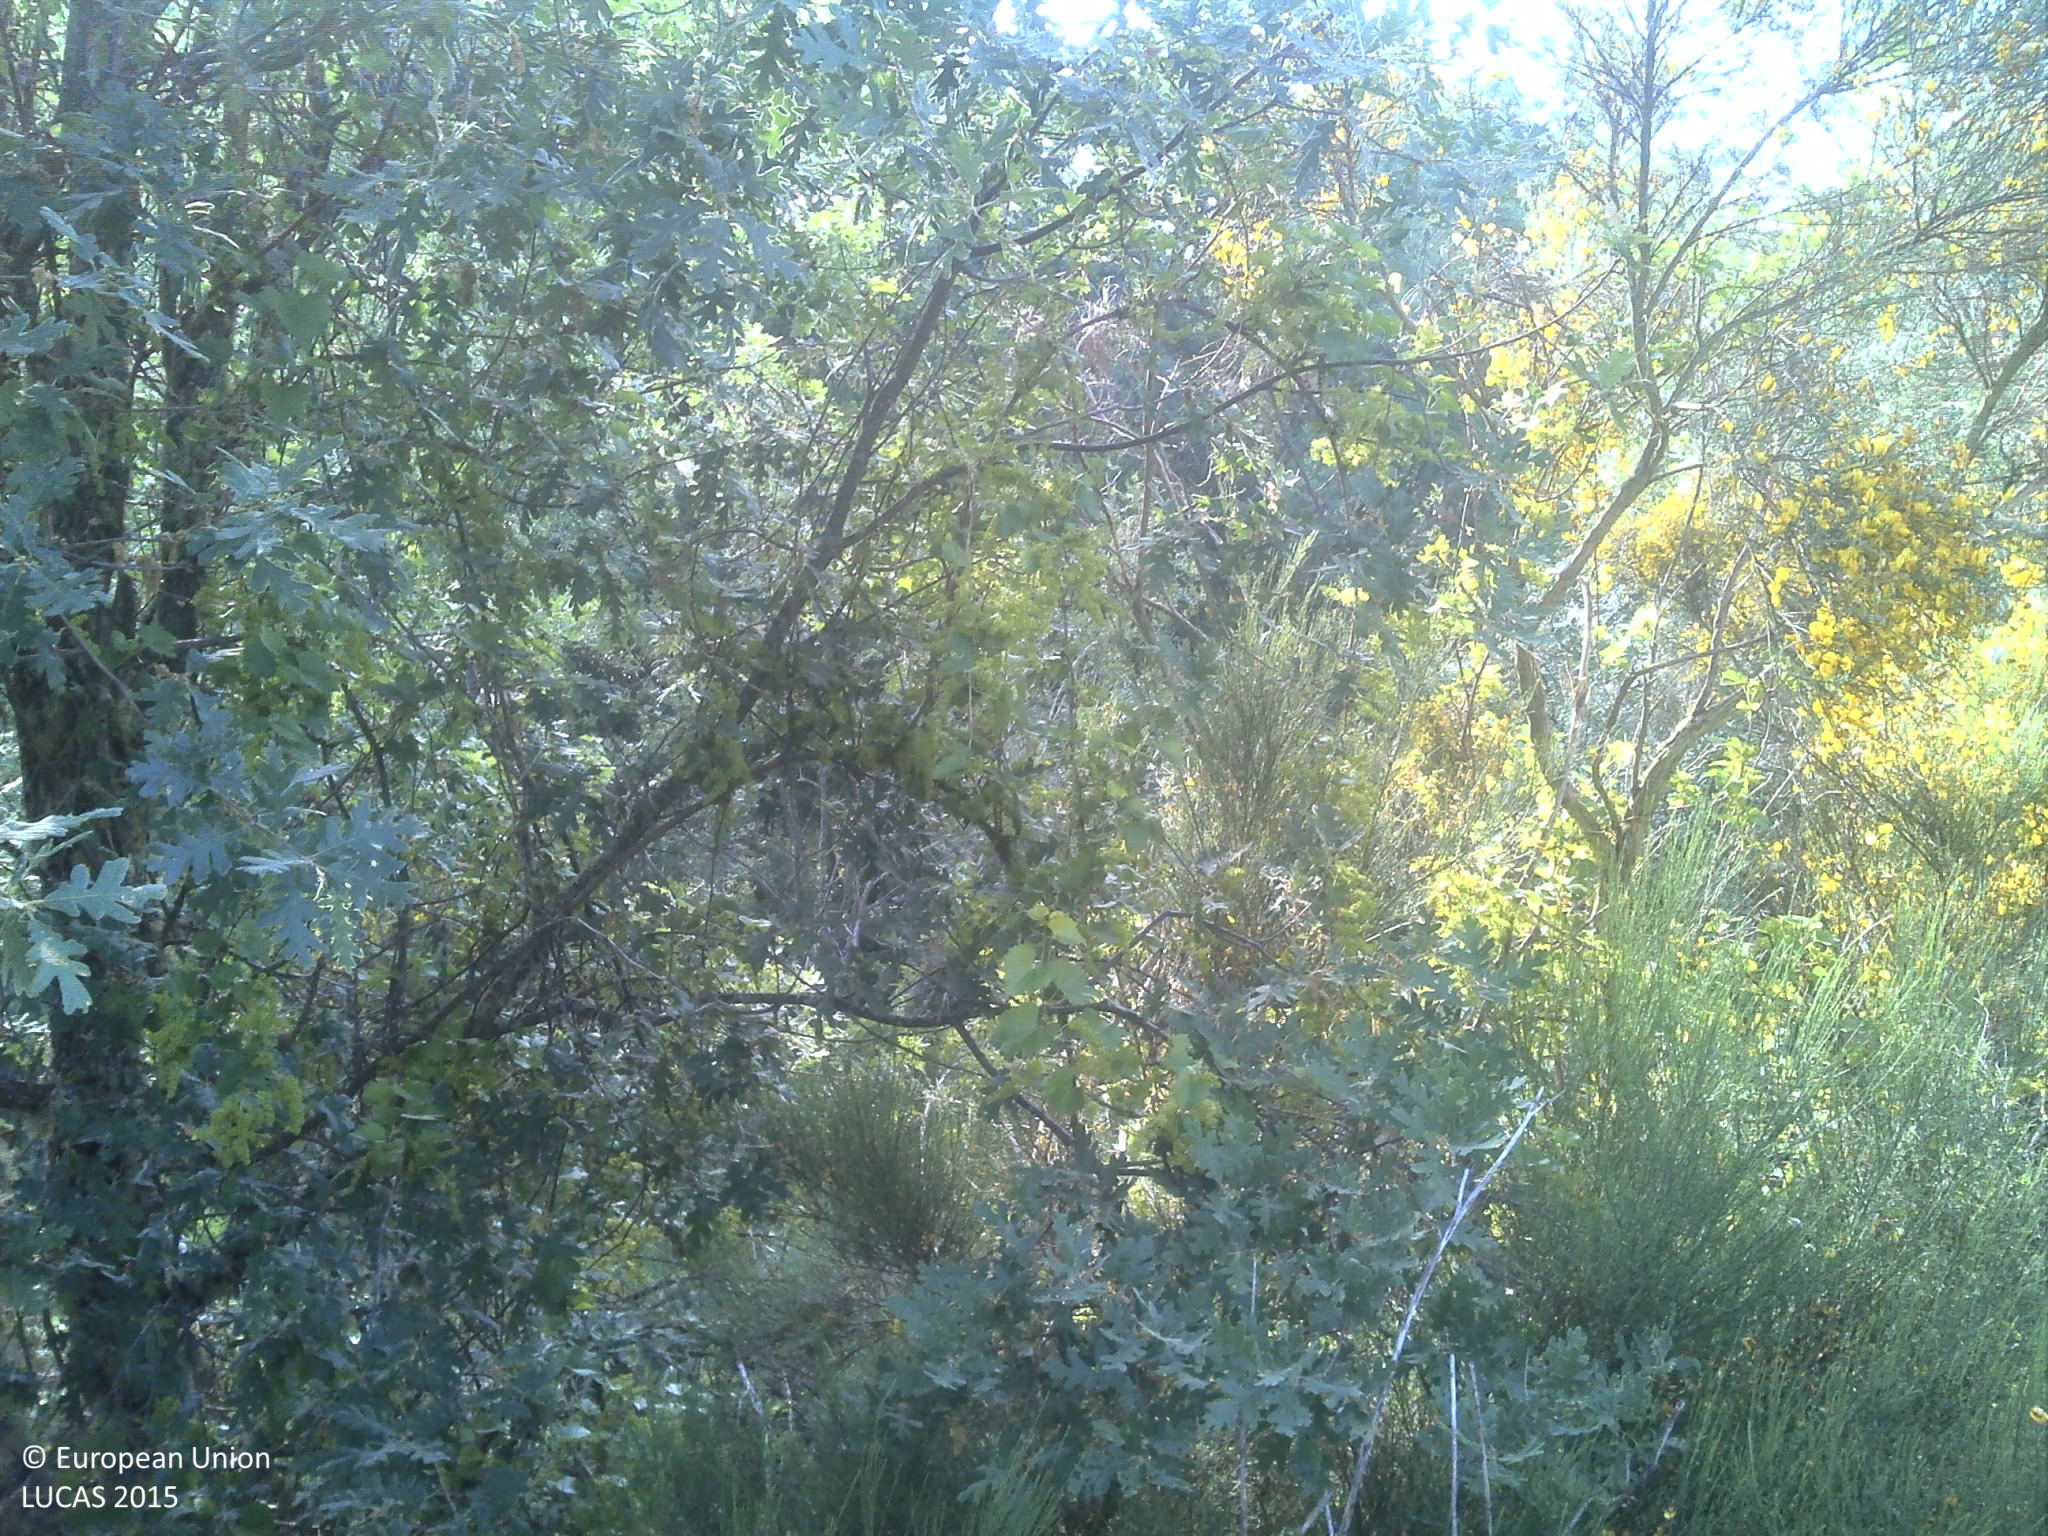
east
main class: Shrubland
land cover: Shrubland without tree cover
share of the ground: 50 - 75 %
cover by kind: shrubs 75 %, unconsolidated bare surface 10 %, herbaceous plants 5 %
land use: Abandoned areas
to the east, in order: Shrubland without tree cover; Dry stone walls; Tracks; Dry stone walls; Shrubland with sparse tree cover; Abandoned hedges; Rivers and streams; Abandoned hedges; Shrubland without tree cover; Dry stone walls; Shrubland without tree cover
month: June
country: PT
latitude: 40.3717
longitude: -7.0213
